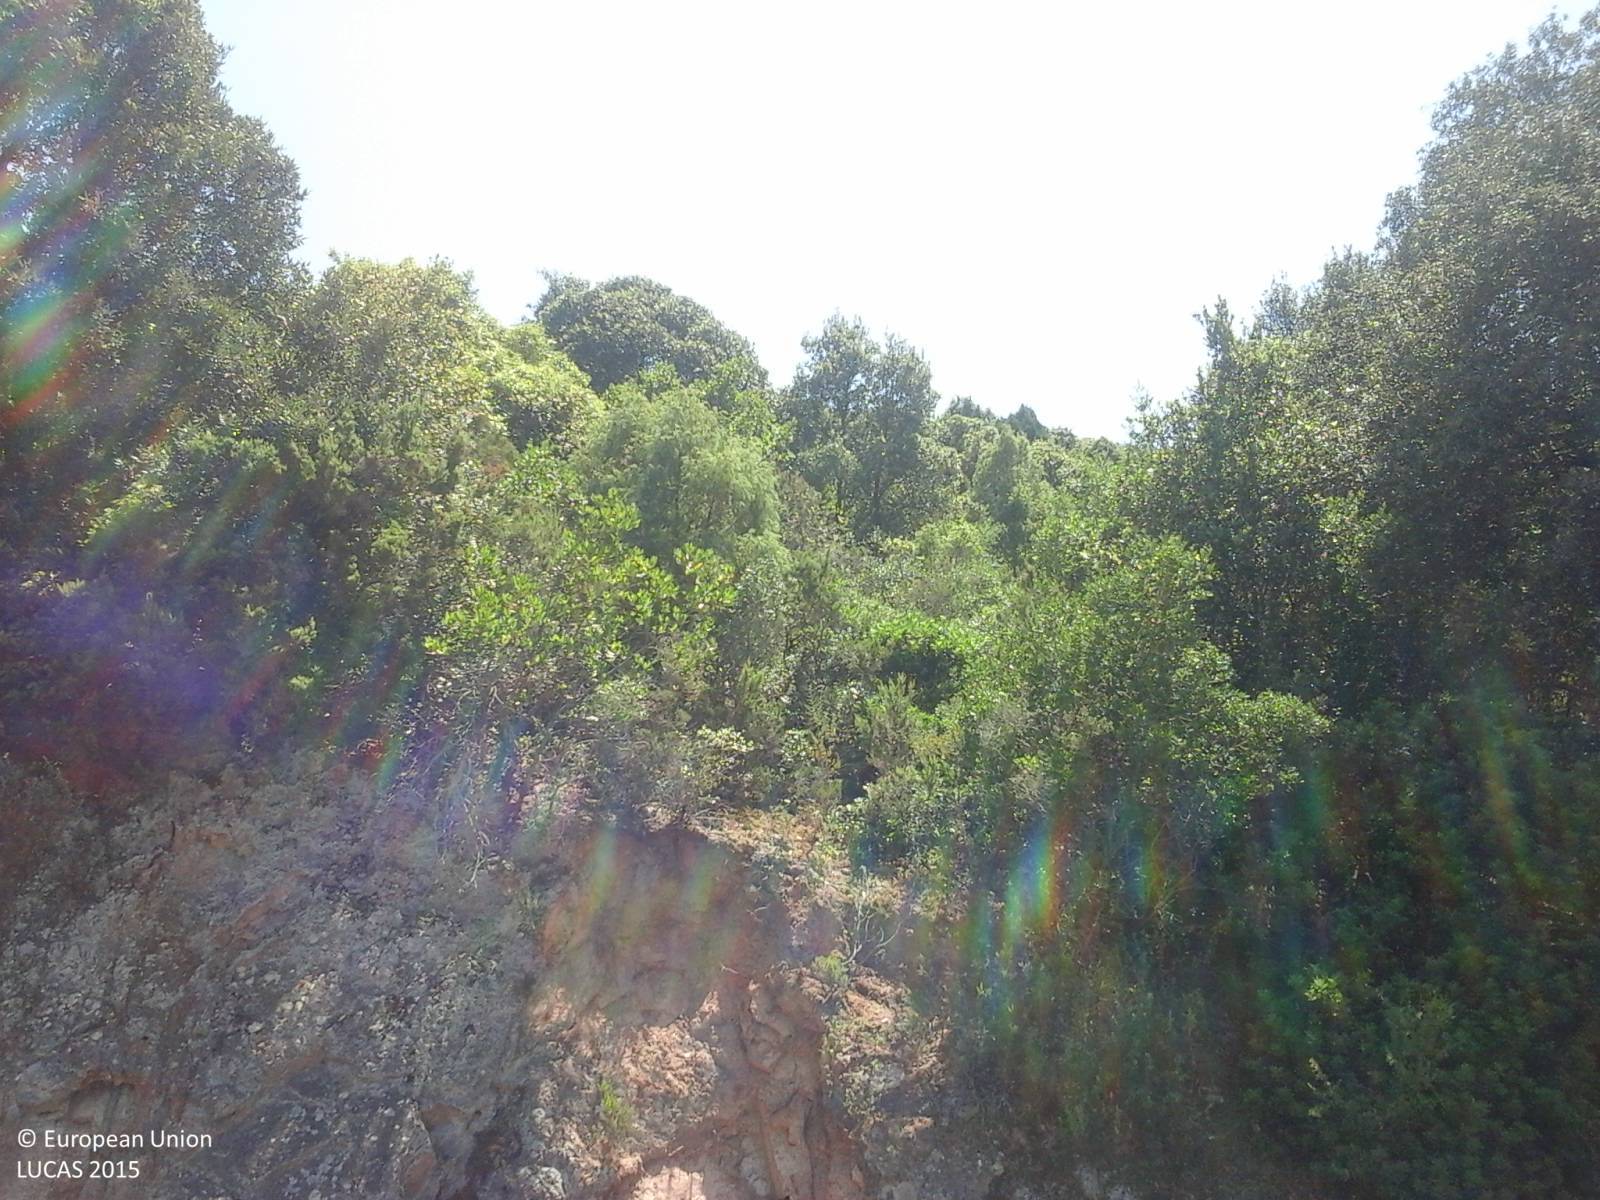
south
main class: Woodland
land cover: Broadleaved woodland
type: broadleaved evergreen forest
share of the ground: > 75 %
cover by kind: broadleaved forest trees 60 %, shrubs 25 %, coniferous forest trees 10 %, herbaceous plants 5 %
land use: Agriculture (excluding fallow land and kitchen gardens)
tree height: > 5 m
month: June
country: IT
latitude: 38.9377
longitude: 8.8194
